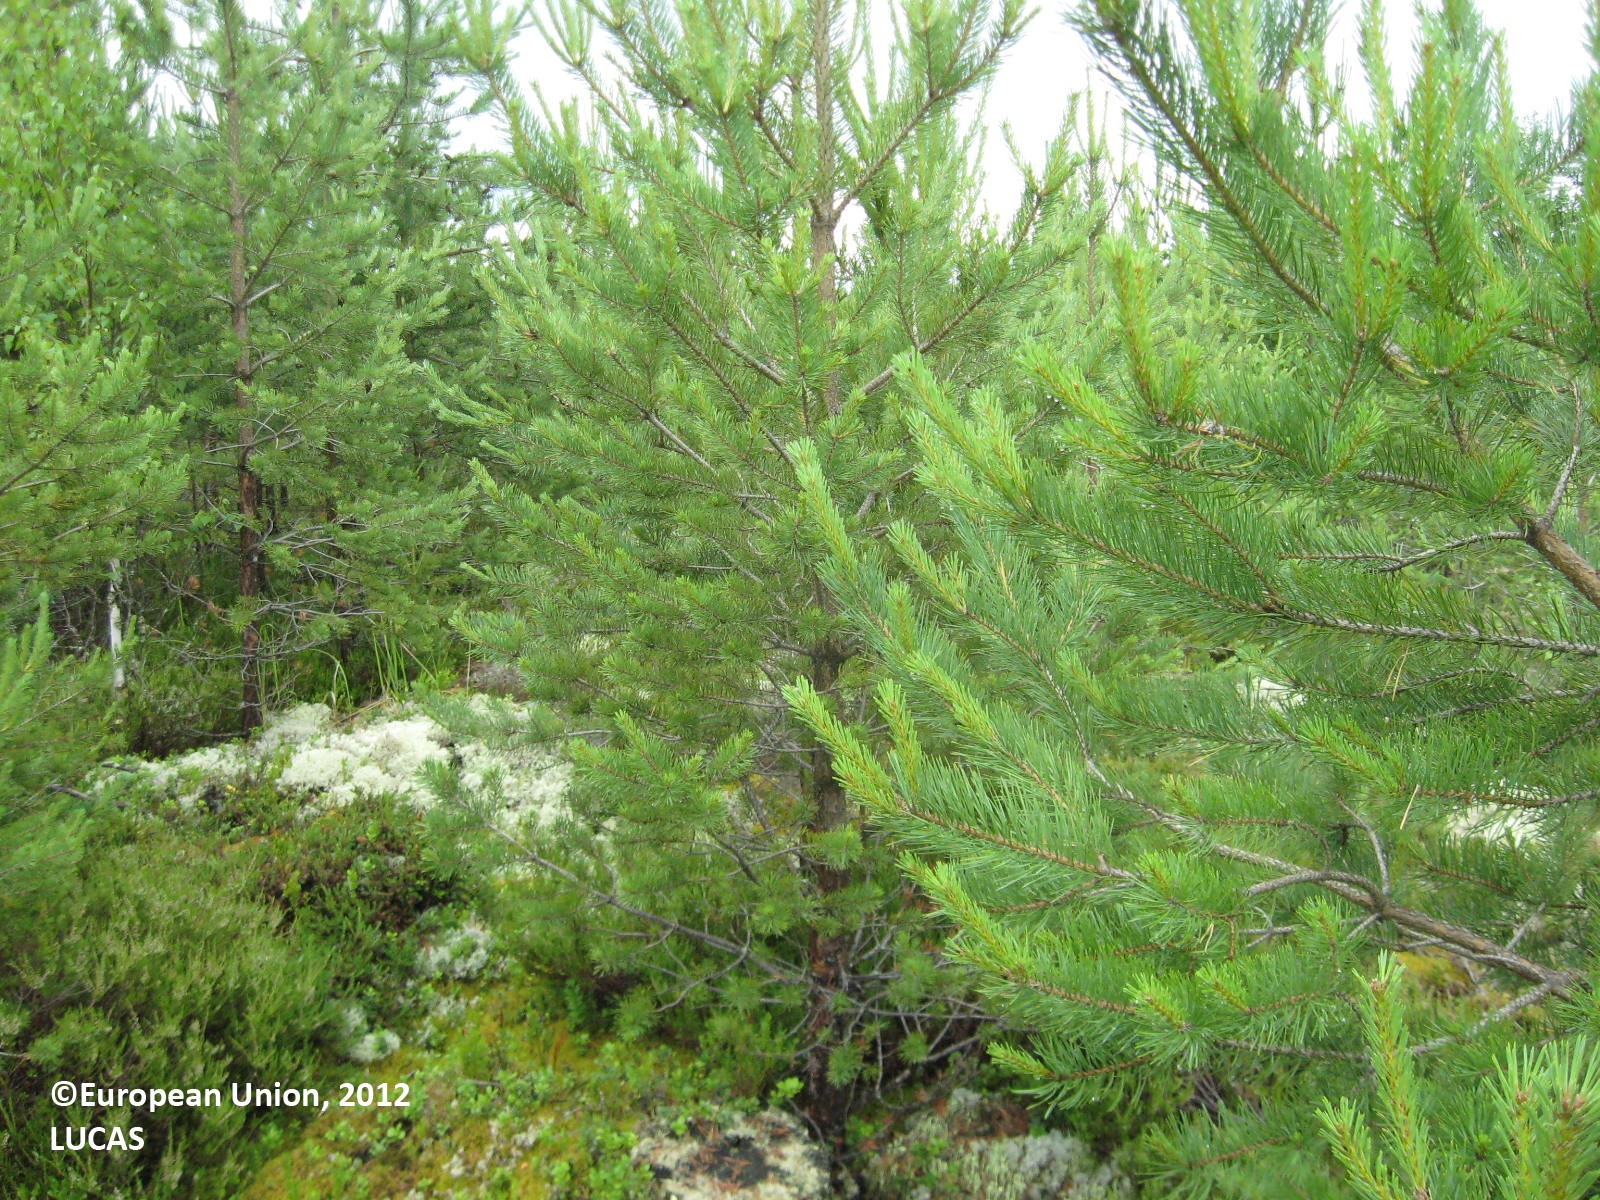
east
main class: Woodland
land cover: Pine dominated coniferous woodland
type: boreal forest
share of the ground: 50 - 75 %
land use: Forestry
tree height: < 5 m
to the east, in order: Pine dominated coniferous woodland; Ditches and canals; Pine dominated coniferous woodland; Ditches and canals; Other mixed woodland; Broadleaved woodland; Other mixed woodland; Ditches and canals; Pine dominated coniferous woodland
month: July
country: FI
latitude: 62.4566
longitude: 22.4812
